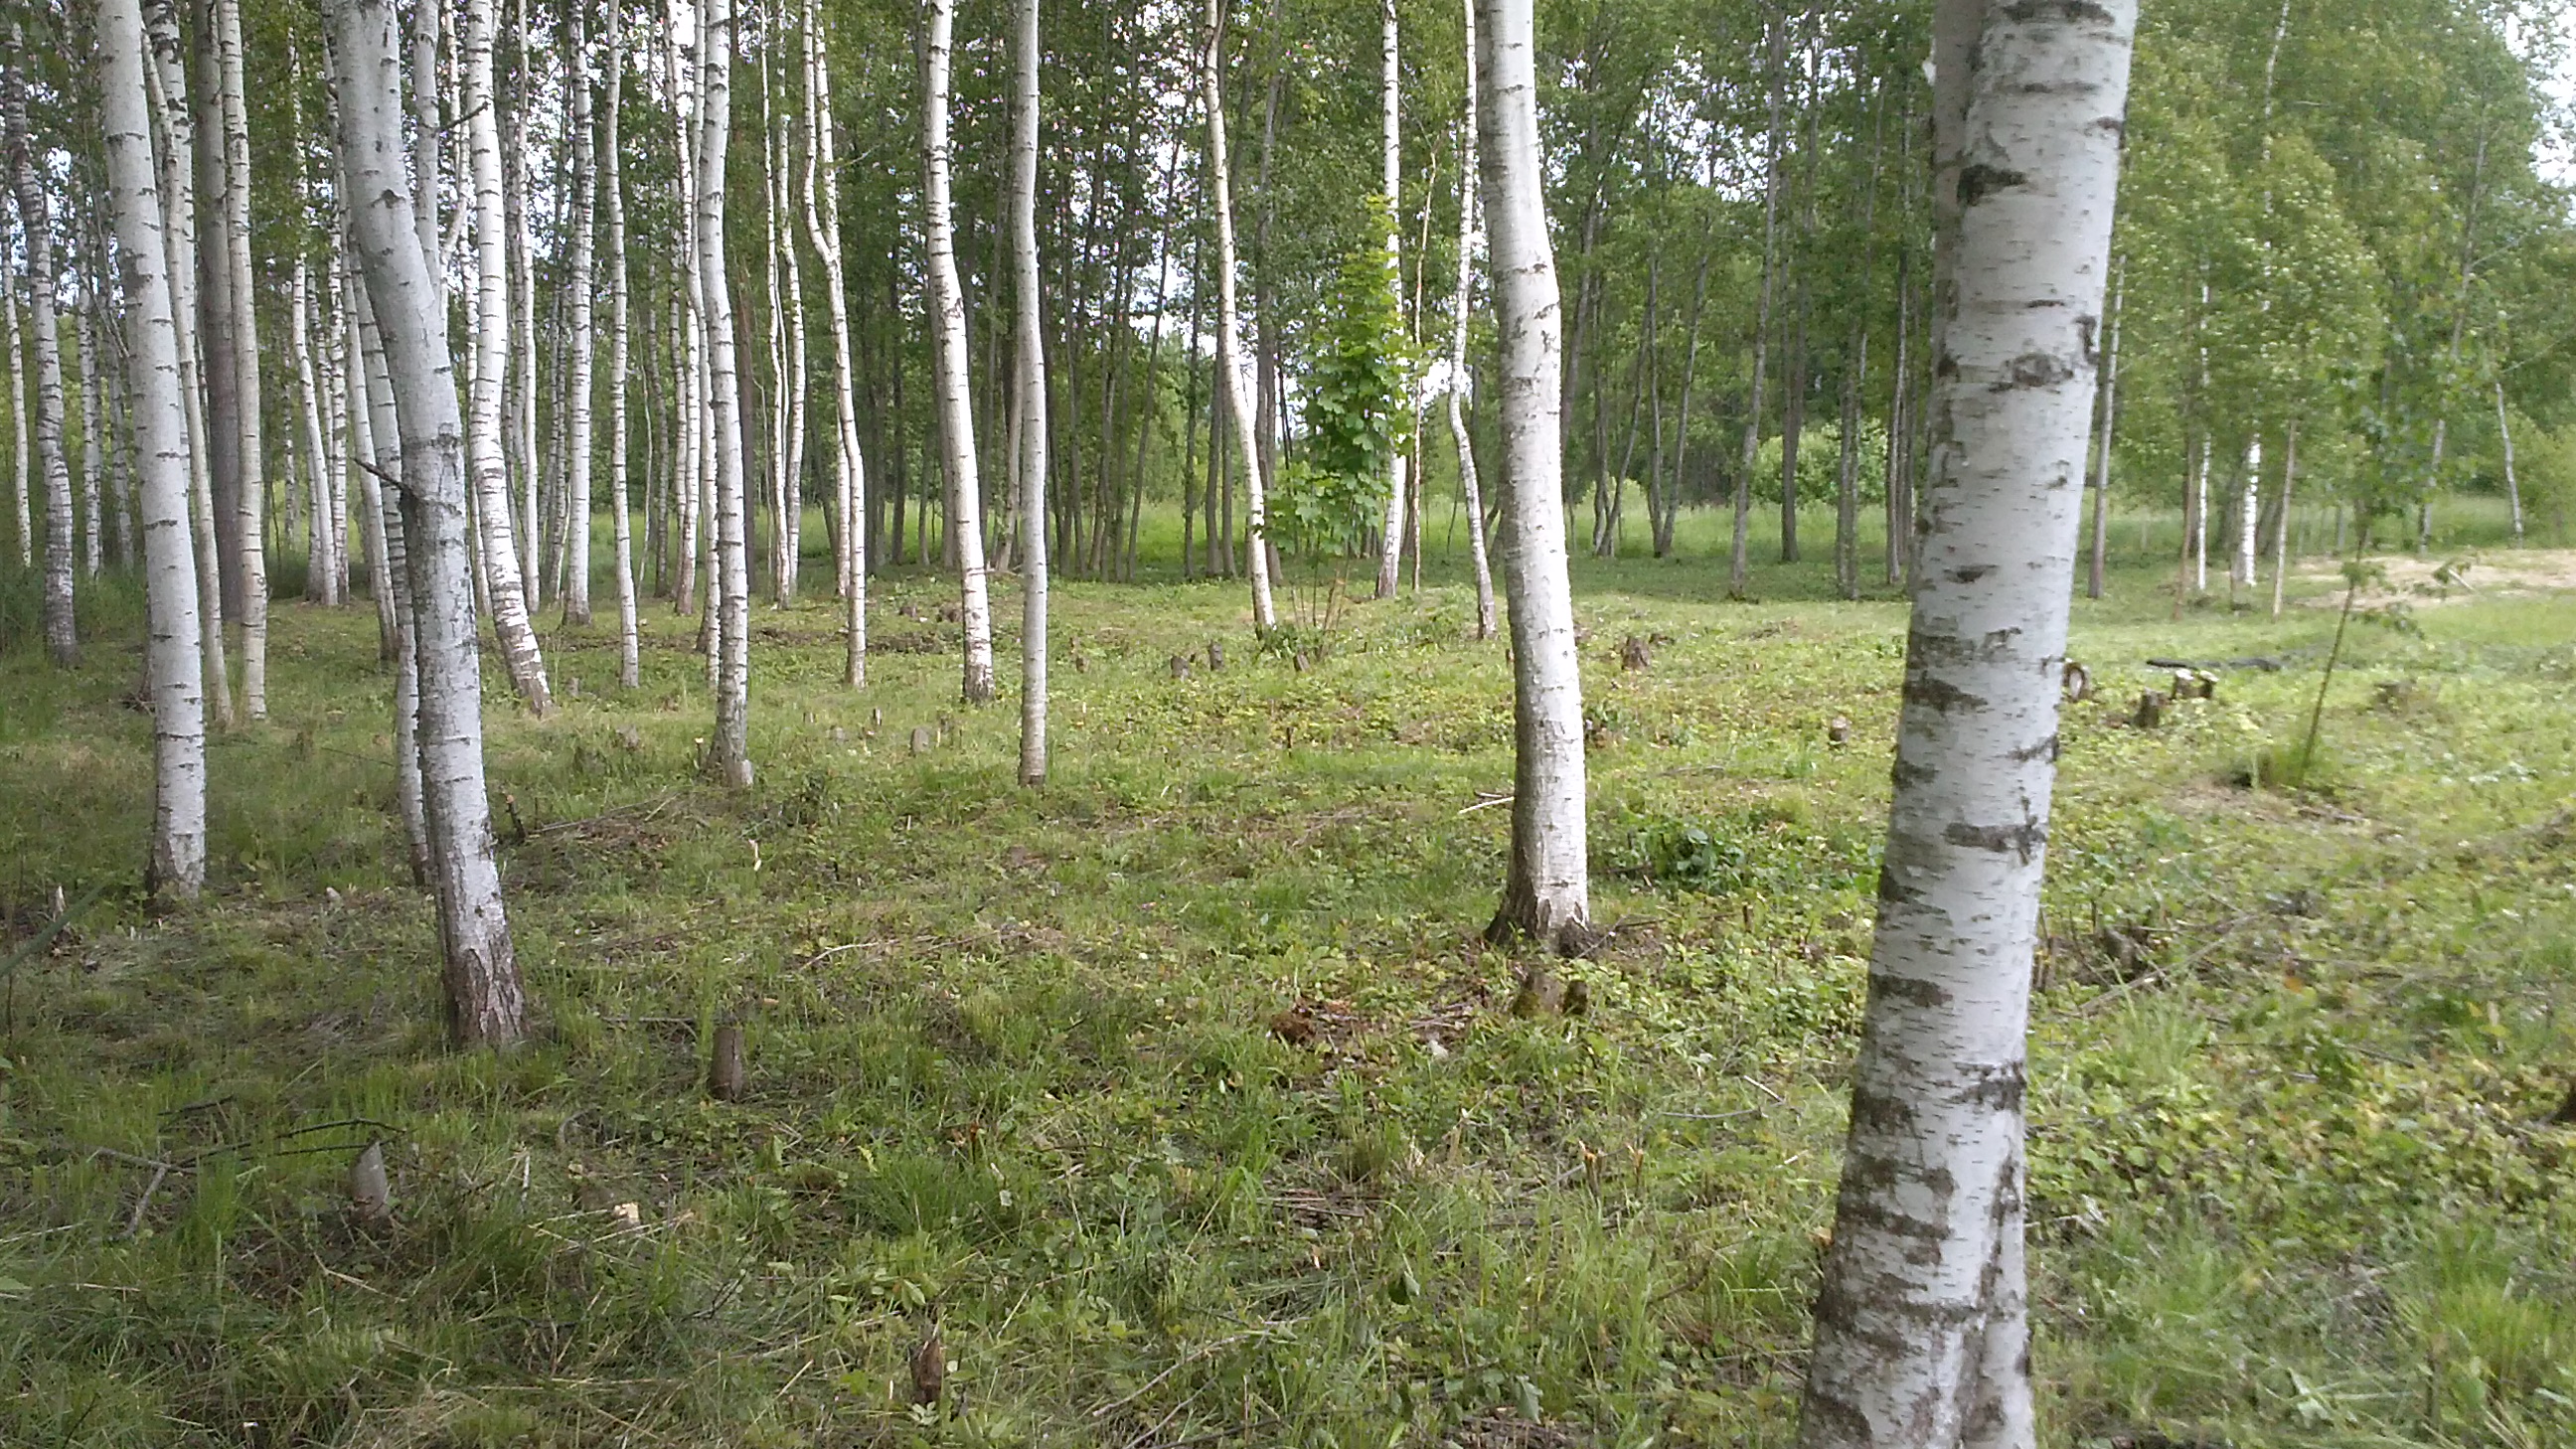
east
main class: Woodland
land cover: Broadleaved woodland
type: non-riverine alder, birch or aspen forest
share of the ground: 50 - 75 %
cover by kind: broadleaved forest trees 70 %, shrubs 20 %, herbaceous plants 10 %
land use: Forestry
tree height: > 5 m
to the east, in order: Broadleaved woodland; Grassland without tree/shrub cover; Paved roads, cycling and walking lanes; Grass margins; Broadleaved woodland; Grassland without tree/shrub cover; Paved roads, cycling and walking lanes; Grass margins; Shrubland without tree cover; Broadleaved woodland
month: June
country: LV
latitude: 56.4745
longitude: 27.3001
